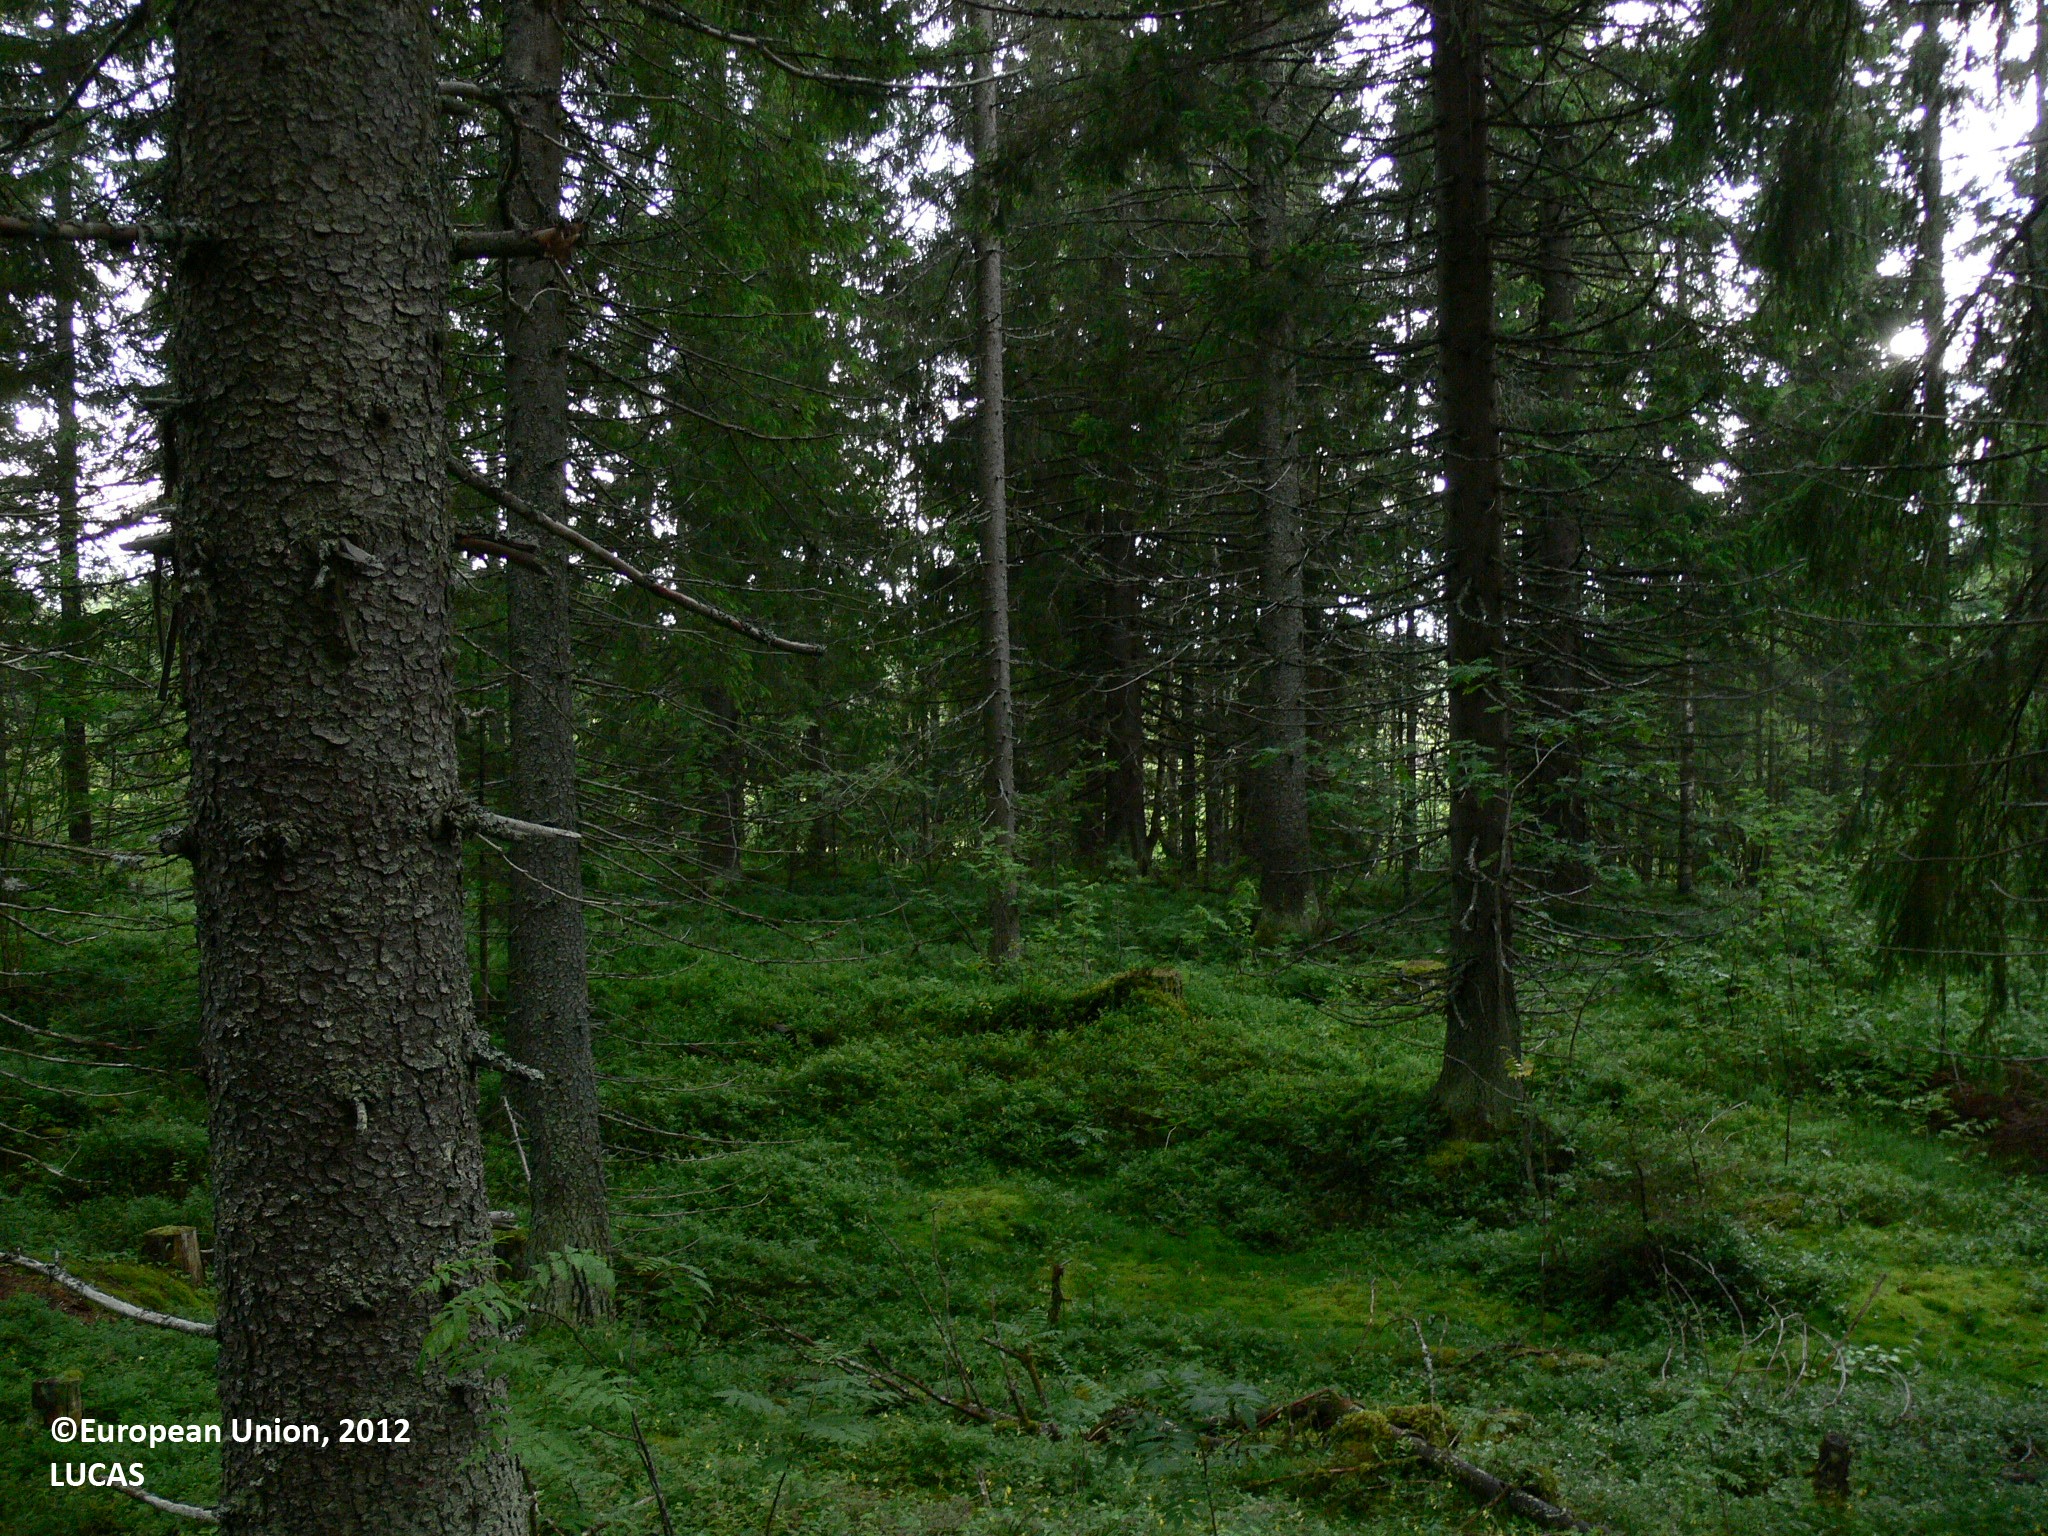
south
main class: Woodland
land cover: Spruce dominated coniferous woodland
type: boreal forest
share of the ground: > 75 %
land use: Forestry
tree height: > 5 m
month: July
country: FI
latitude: 63.1315
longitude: 29.2000
